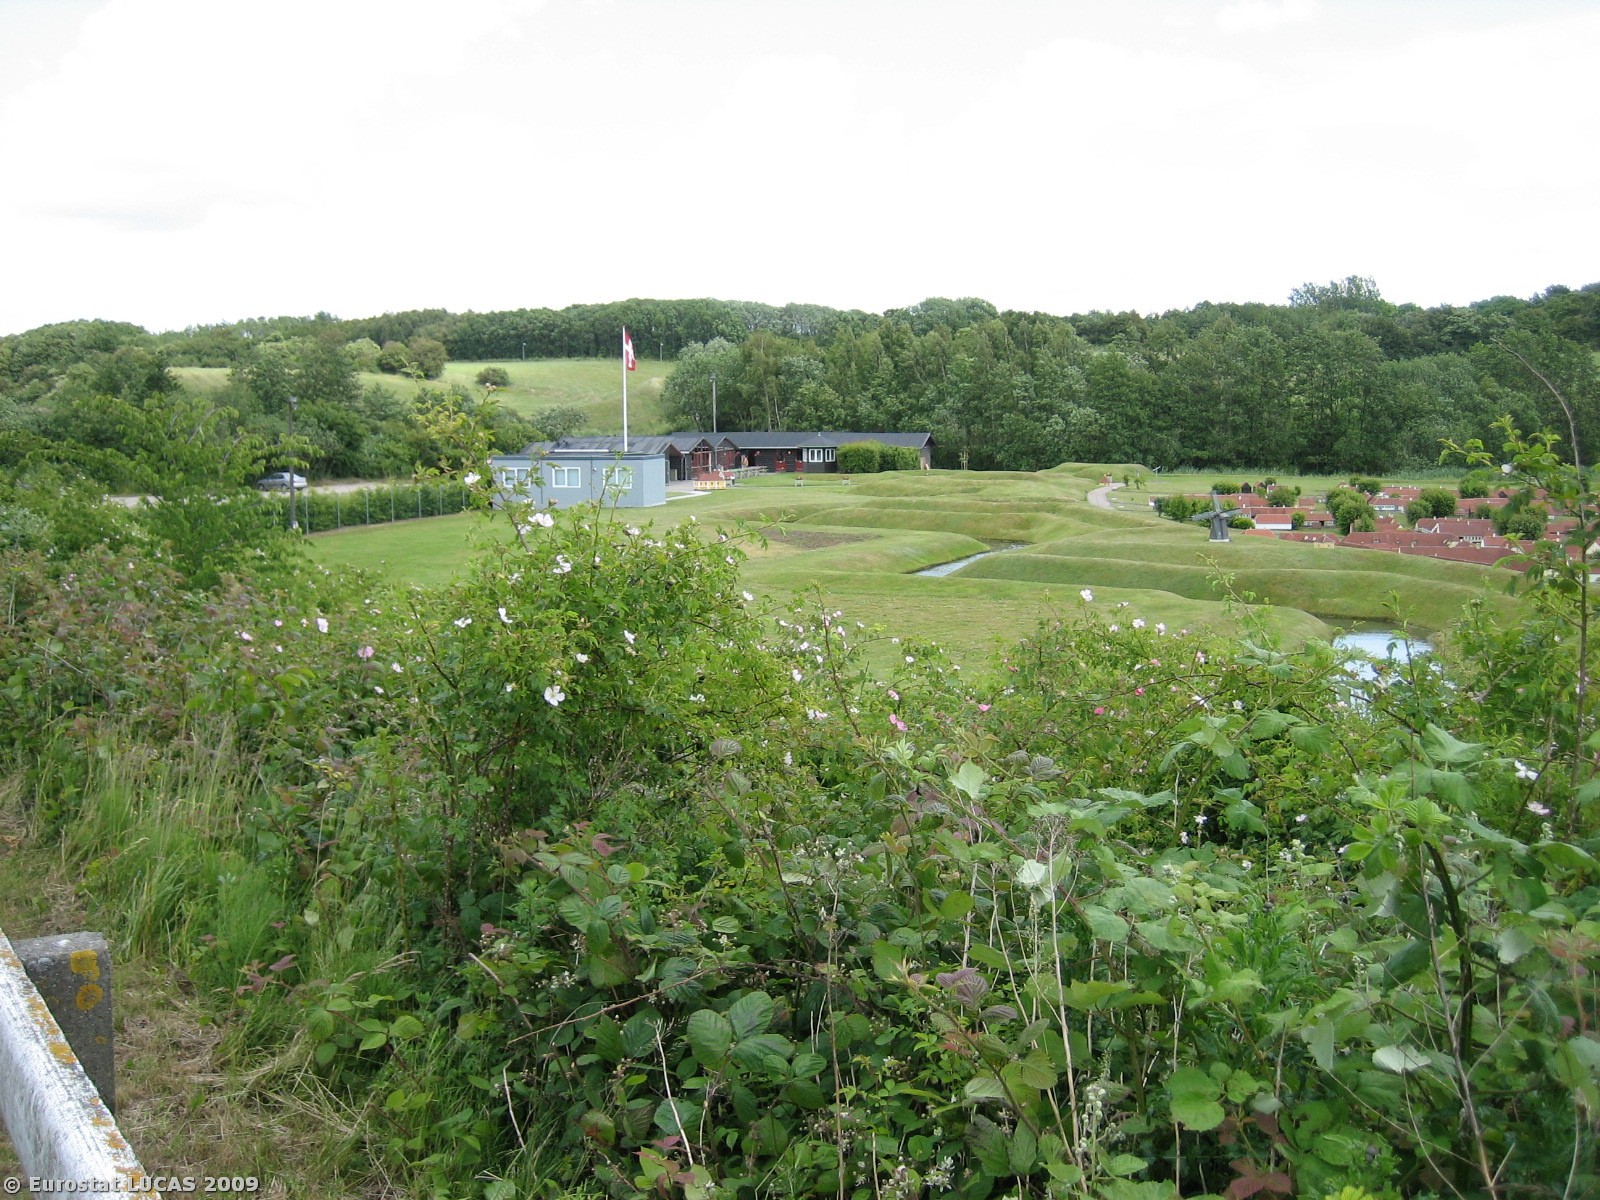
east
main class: Grassland
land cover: Grassland without tree/shrub cover
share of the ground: > 75 %
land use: Amenities, museums, leisure
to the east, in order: Grassland without tree/shrub cover; Artificial constructions in urban areas; Grassland without tree/shrub cover; Inland marshes; Inland water bodies; Inland marshes; Broadleaved woodland; Tracks; Shrubland with sparse tree cover; Fences; Grassland without tree/shrub cover
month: June
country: DK
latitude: 55.5763
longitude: 9.7306
